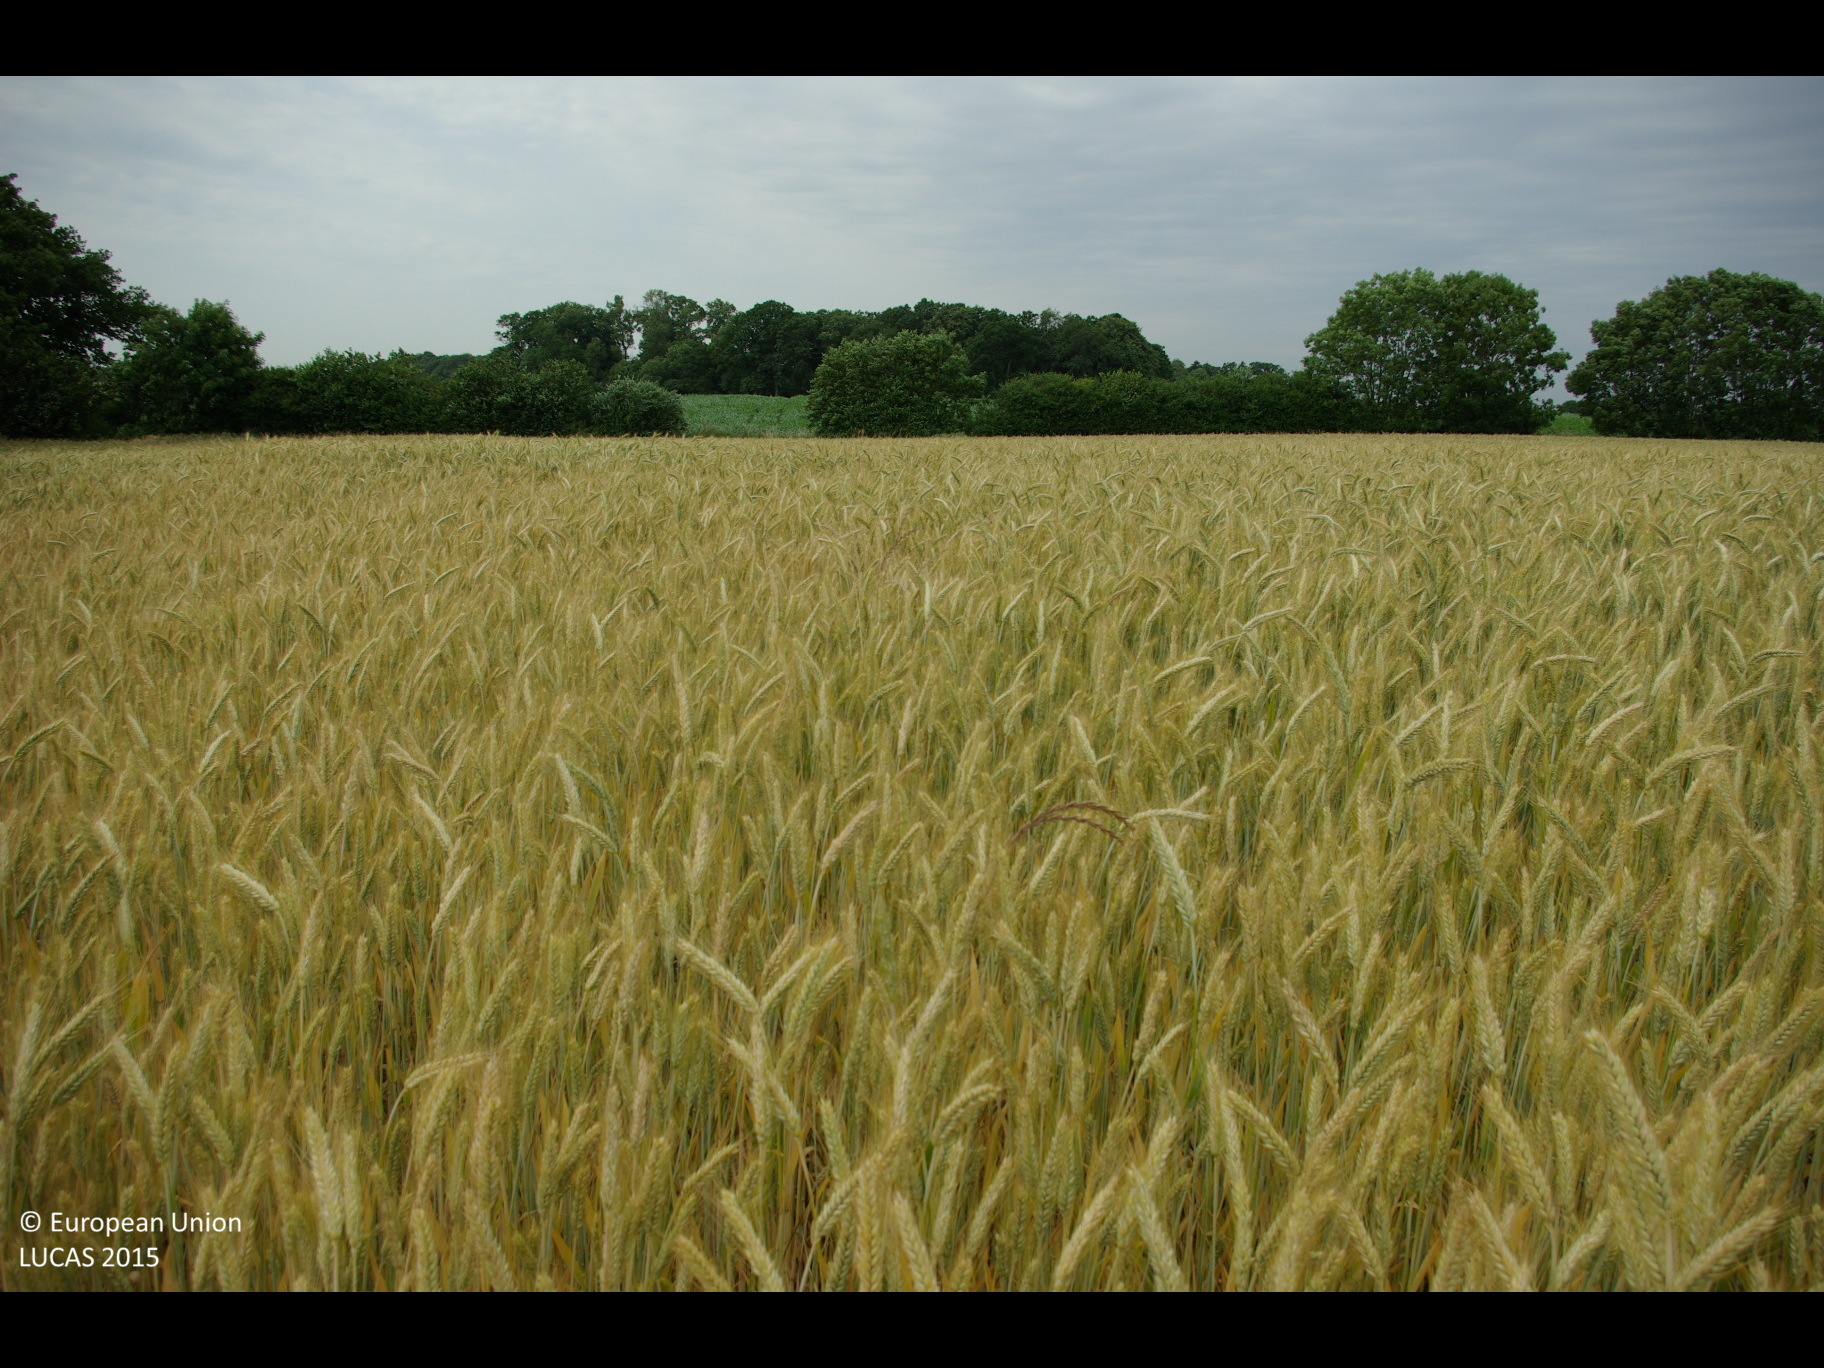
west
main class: Cropland
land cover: Triticale
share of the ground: > 75 %
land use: Agriculture (excluding fallow land and kitchen gardens)
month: July
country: DE
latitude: 54.7498
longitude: 9.9224
